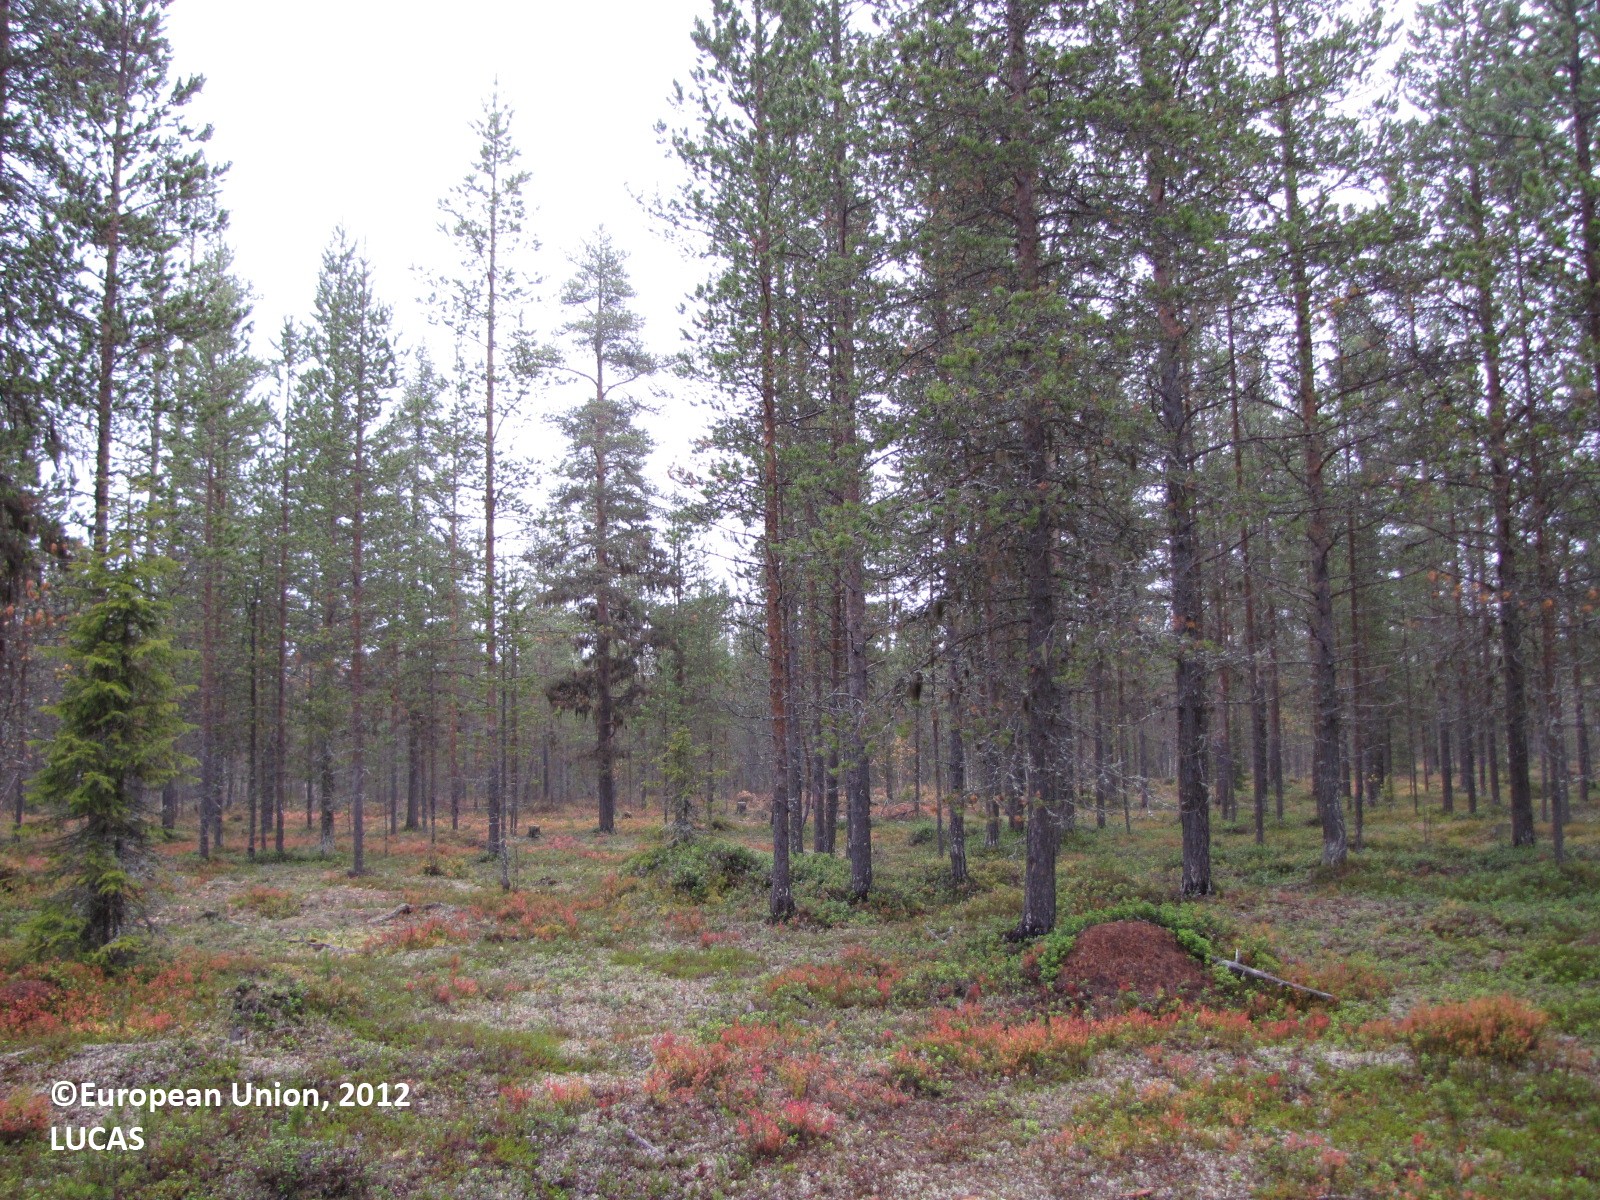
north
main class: Woodland
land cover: Pine dominated coniferous woodland
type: boreal forest
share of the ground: 25 - 50 %
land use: Forestry
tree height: > 5 m
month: September
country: FI
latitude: 67.4132
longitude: 24.1416
